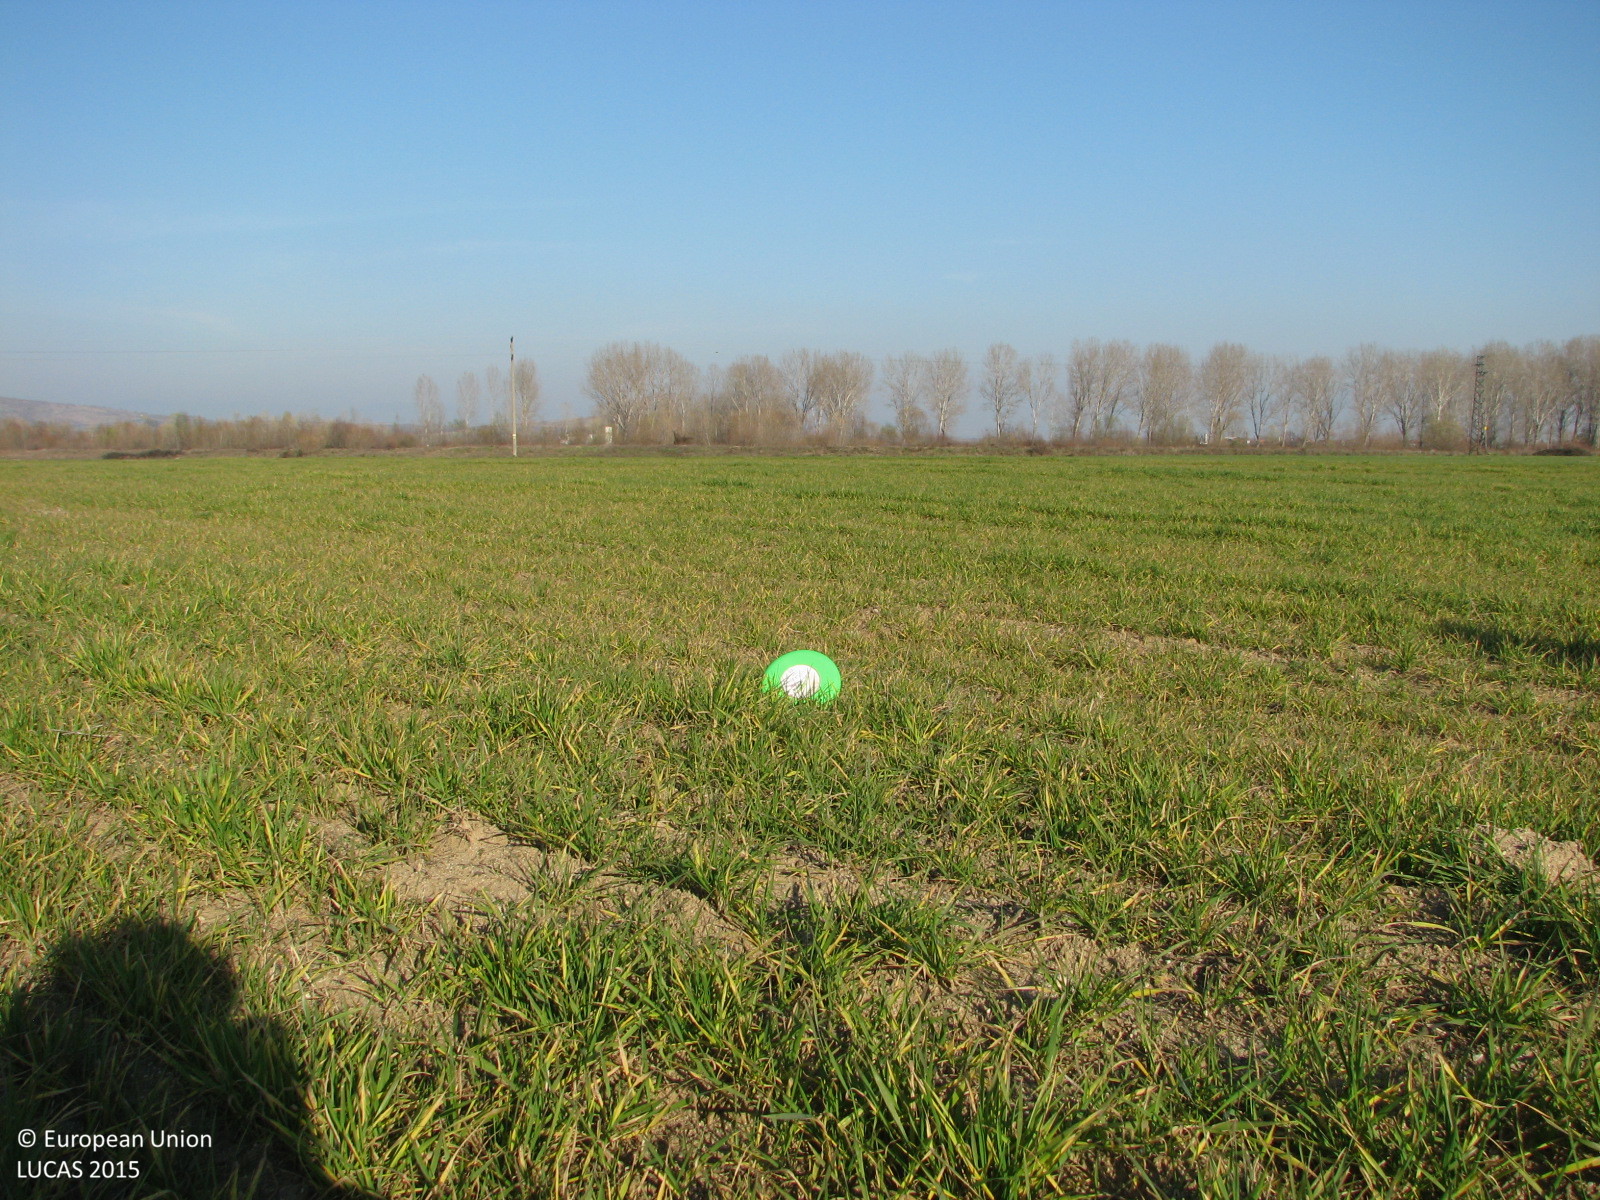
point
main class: Cropland
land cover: Common wheat
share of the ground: > 75 %
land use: Agriculture (excluding fallow land and kitchen gardens)
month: December
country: BG
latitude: 42.2005
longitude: 24.1756
